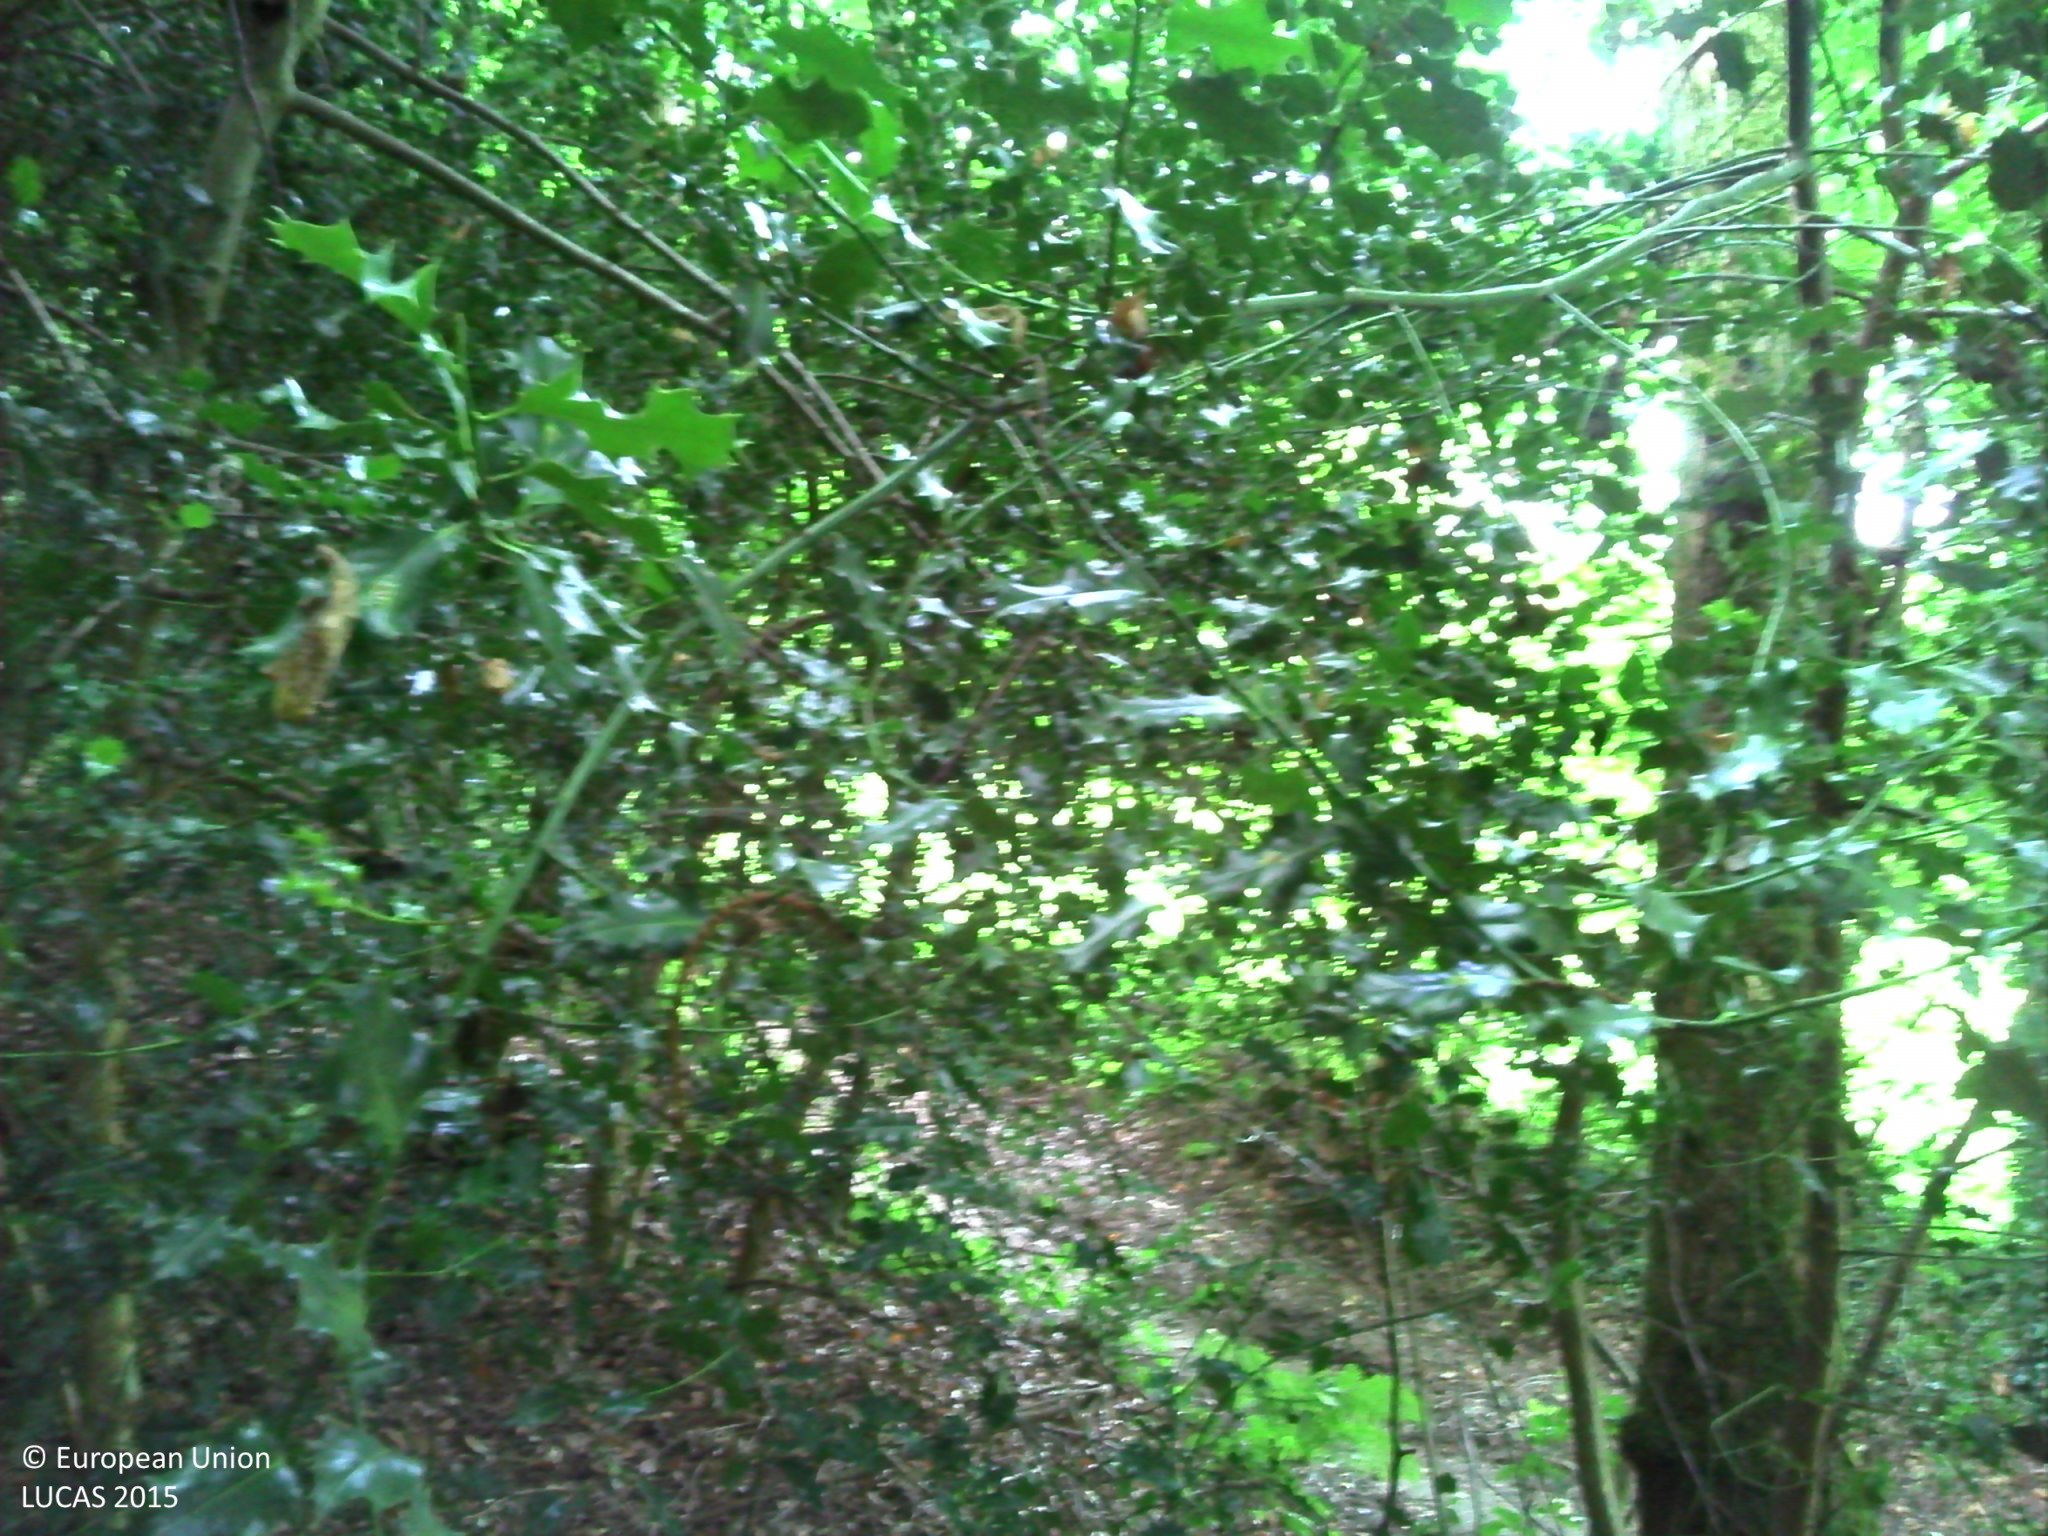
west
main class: Woodland
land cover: Broadleaved woodland
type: beech forest
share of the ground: > 75 %
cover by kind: broadleaved forest trees 95 %, shrubs 5 %
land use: Forestry
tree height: > 5 m
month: August
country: FR
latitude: 48.6961
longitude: -1.2806
